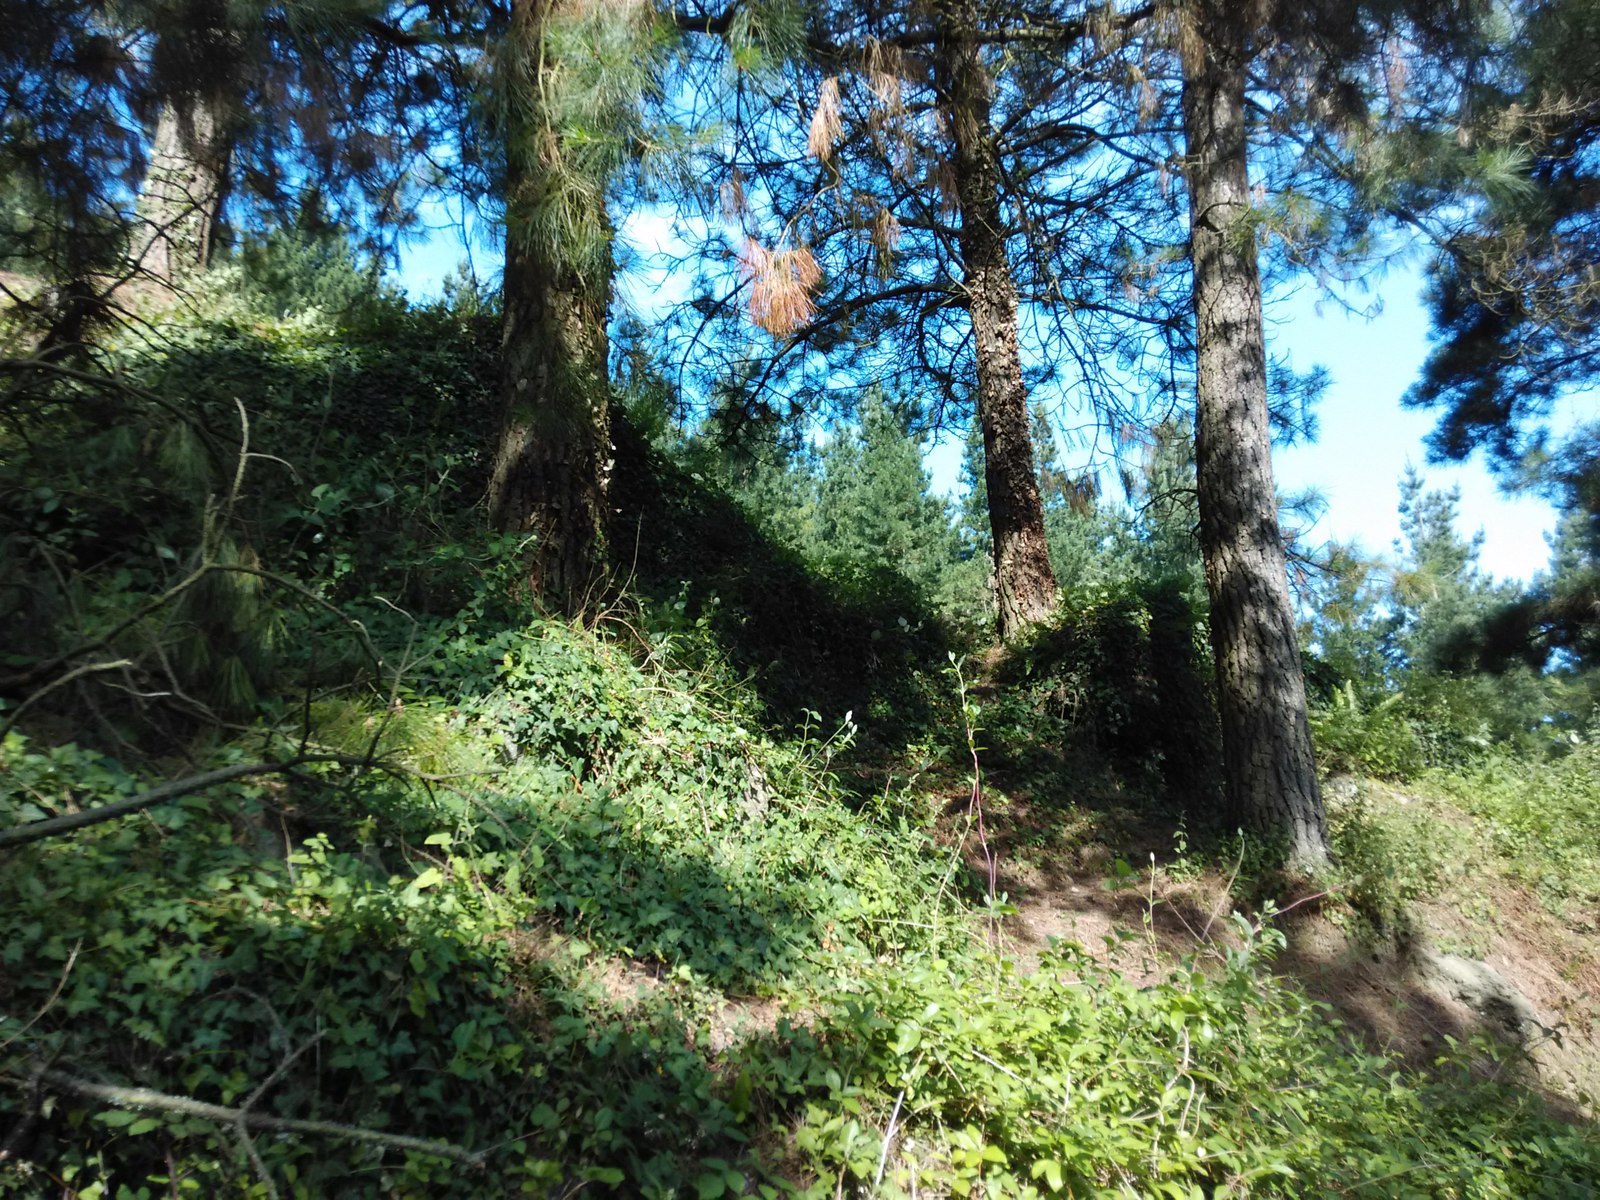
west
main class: Woodland
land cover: Pine dominated coniferous woodland
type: exotic forest
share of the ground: > 75 %
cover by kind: coniferous forest trees 85 %, herbaceous plants 10 %, unconsolidated bare surface 5 %
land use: Forestry
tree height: > 5 m
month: July
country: ES
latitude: 43.1586
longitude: -2.3112
